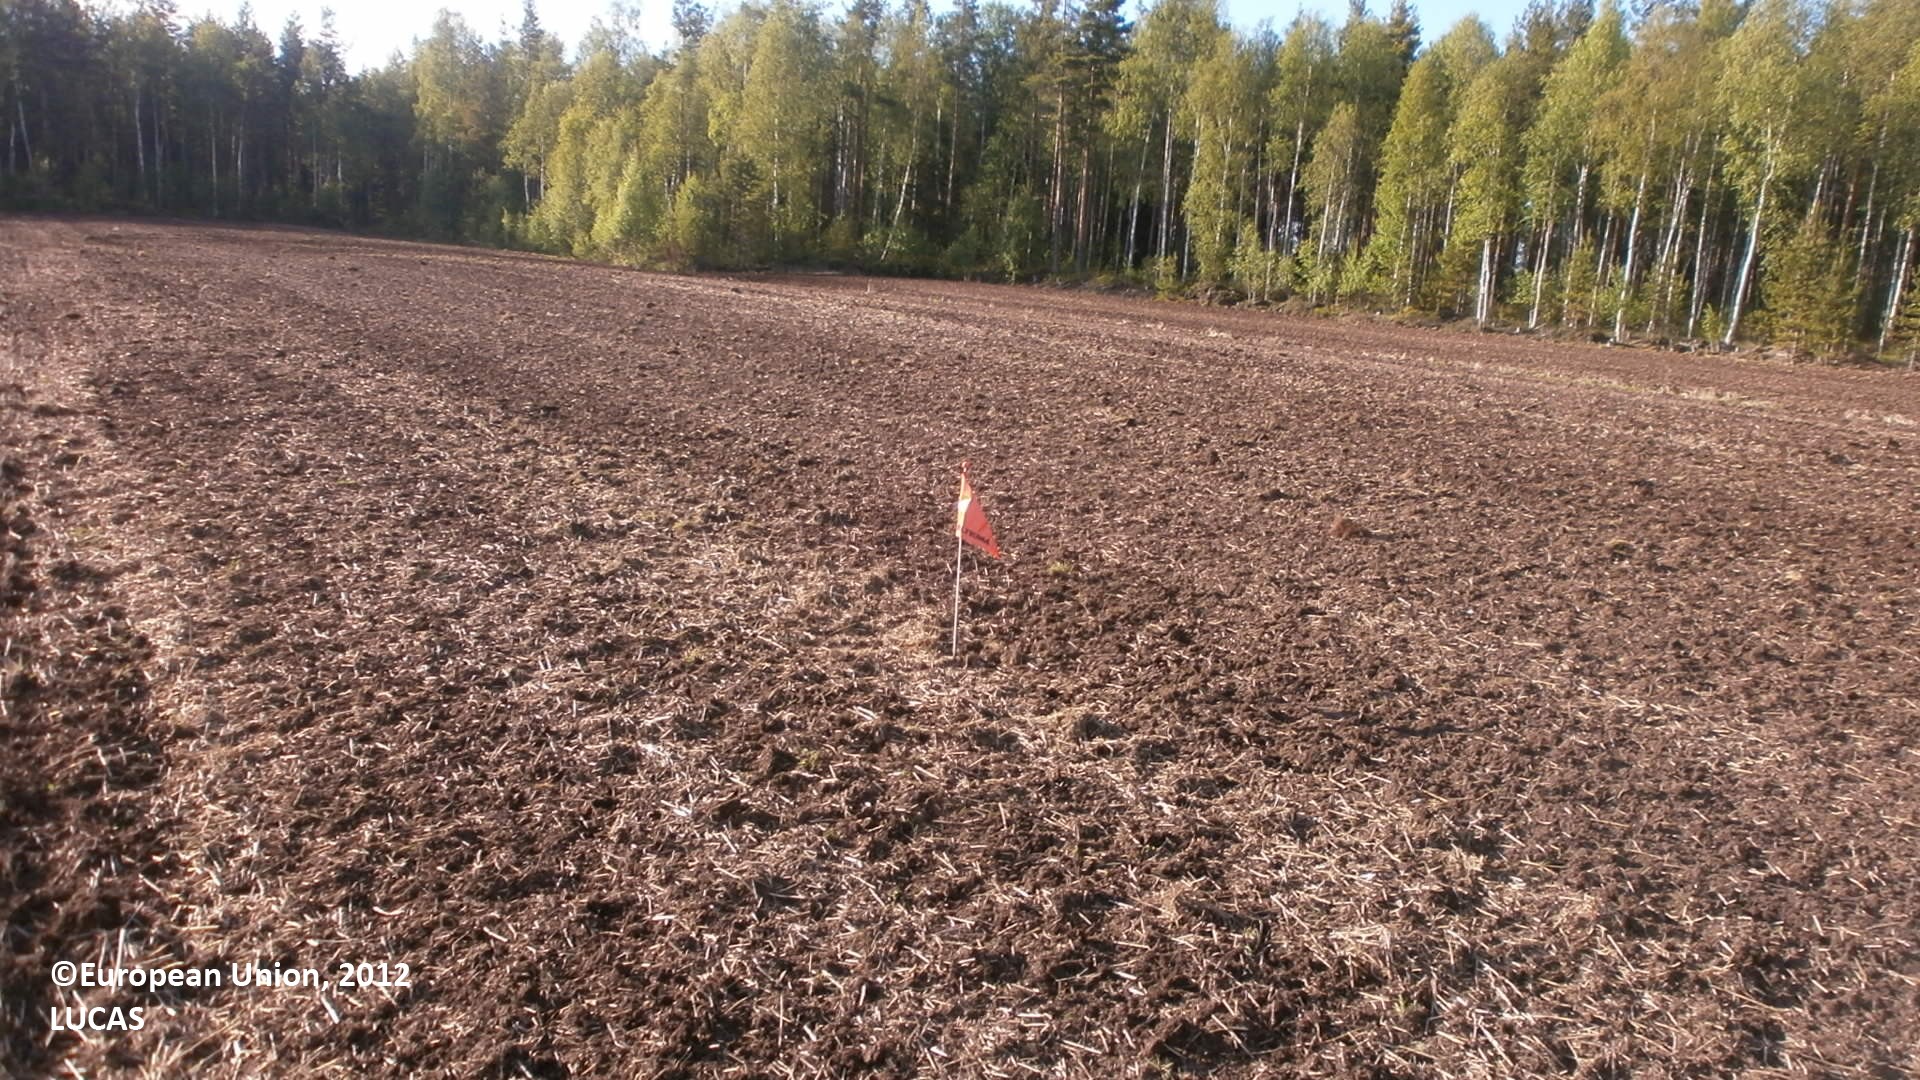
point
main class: Cropland
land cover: Barley
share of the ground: < 10 %
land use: Agriculture (excluding fallow land and kitchen gardens)
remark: Tilled/Sowed
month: June
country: FI
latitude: 64.5228
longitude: 25.0611
